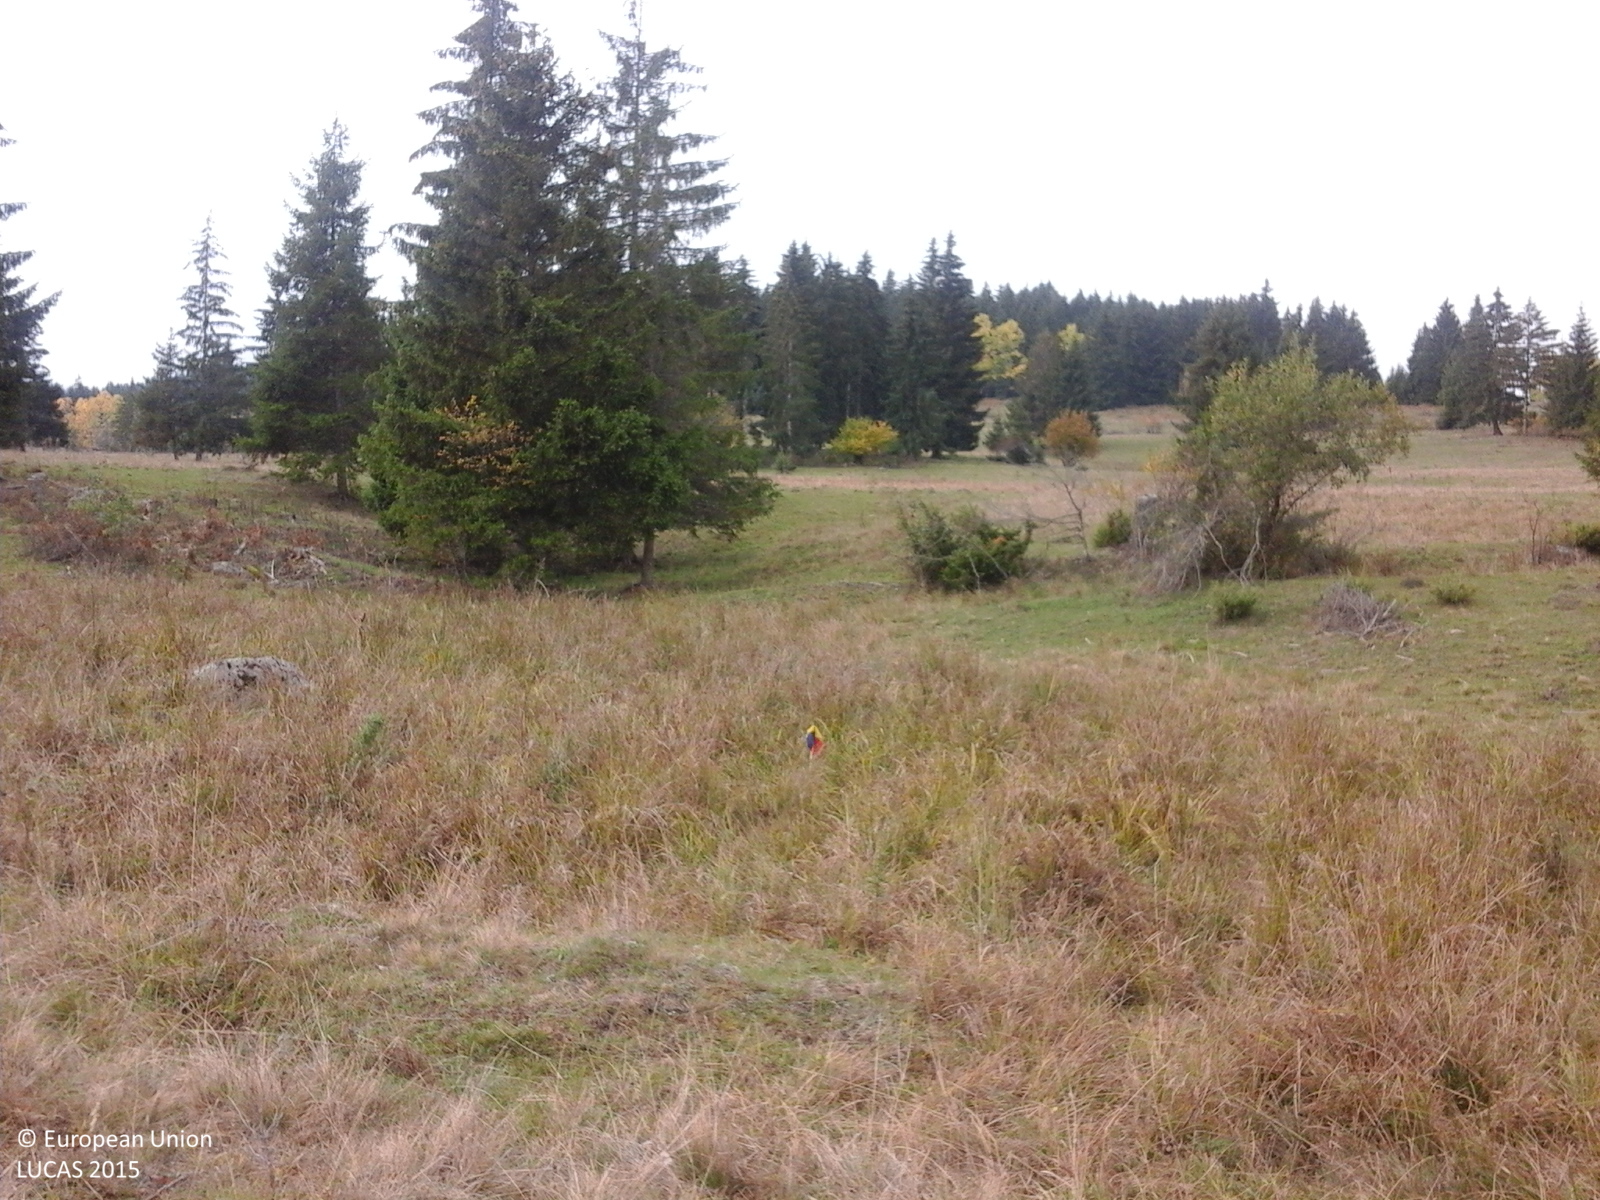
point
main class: Grassland
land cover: Grassland without tree/shrub cover
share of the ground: > 75 %
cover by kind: herbaceous plants 100 %
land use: Agriculture (excluding fallow land and kitchen gardens)
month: October
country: RO
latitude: 46.2852
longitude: 25.8065
